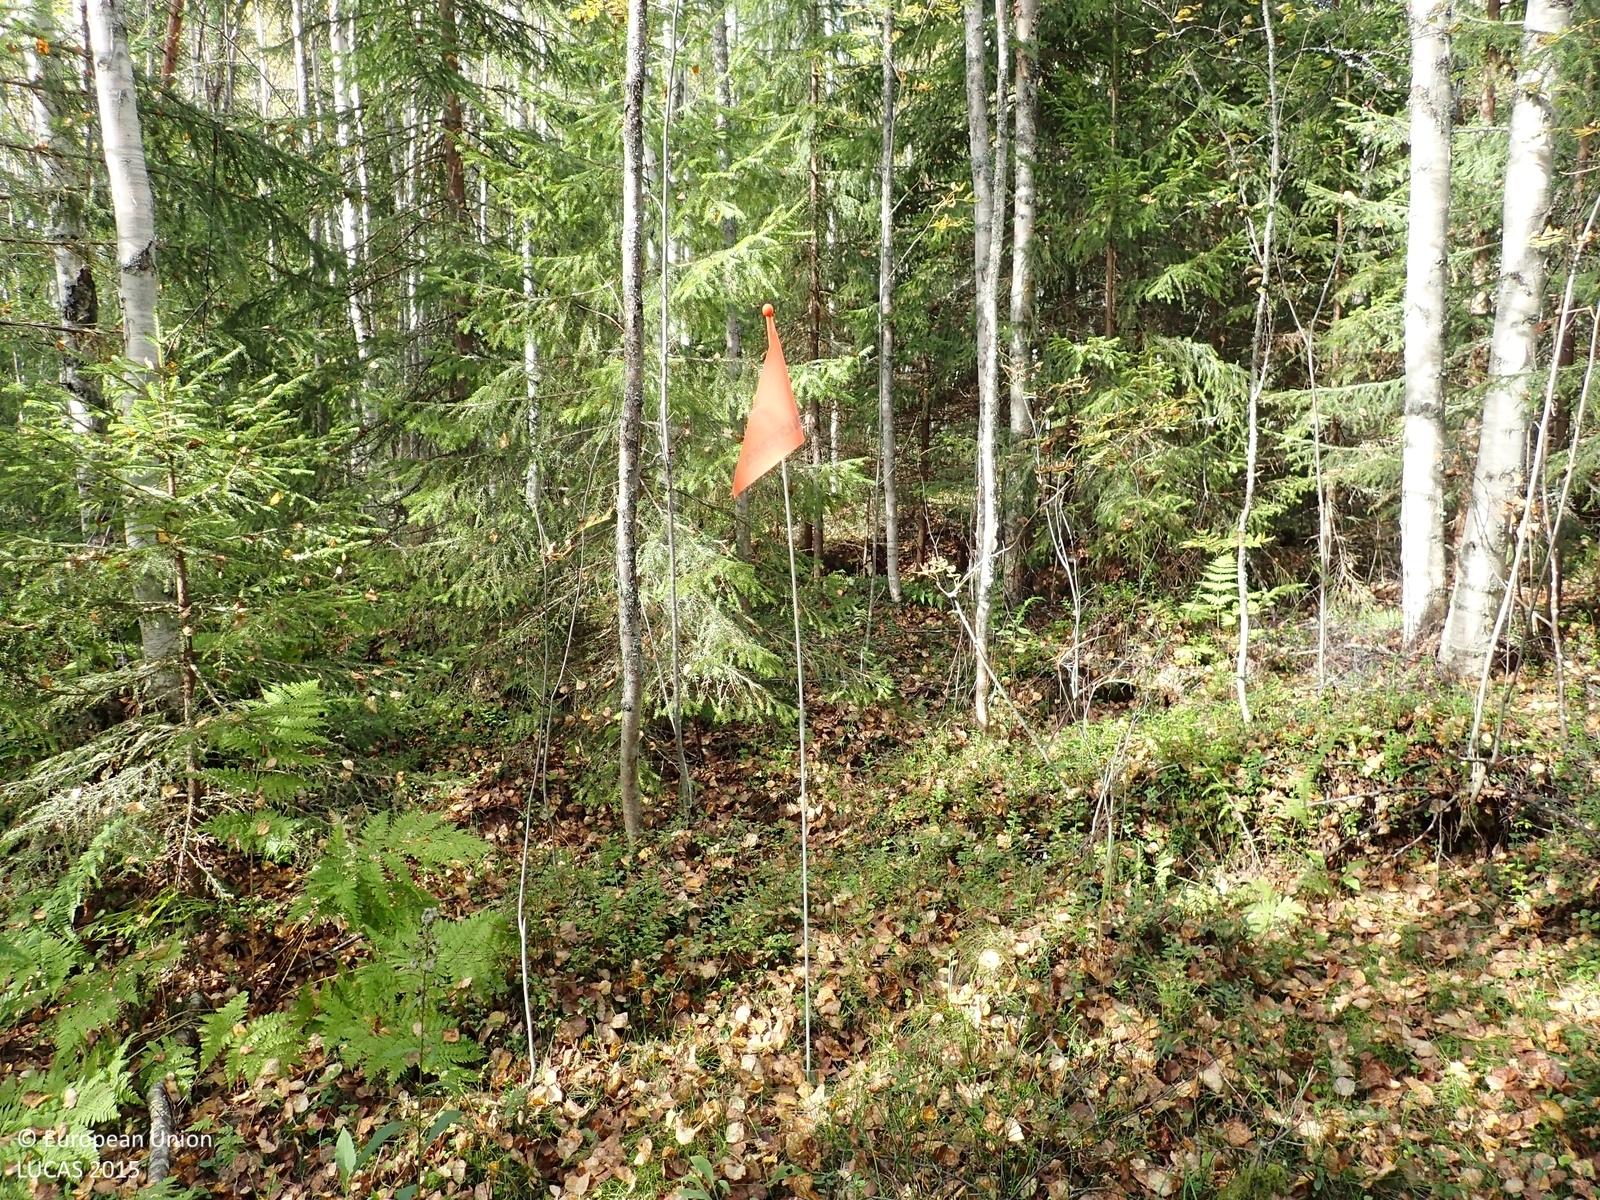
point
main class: Woodland
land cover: Spruce dominated mixed woodland
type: boreal forest
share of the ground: > 75 %
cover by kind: broadleaved forest trees 50 %, coniferous forest trees 30 %, shrubs 10 %, herbaceous plants 5 %, lichens and mosses 5 %
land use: Forestry
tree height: > 5 m
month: September
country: FI
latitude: 63.1738
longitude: 26.1494
